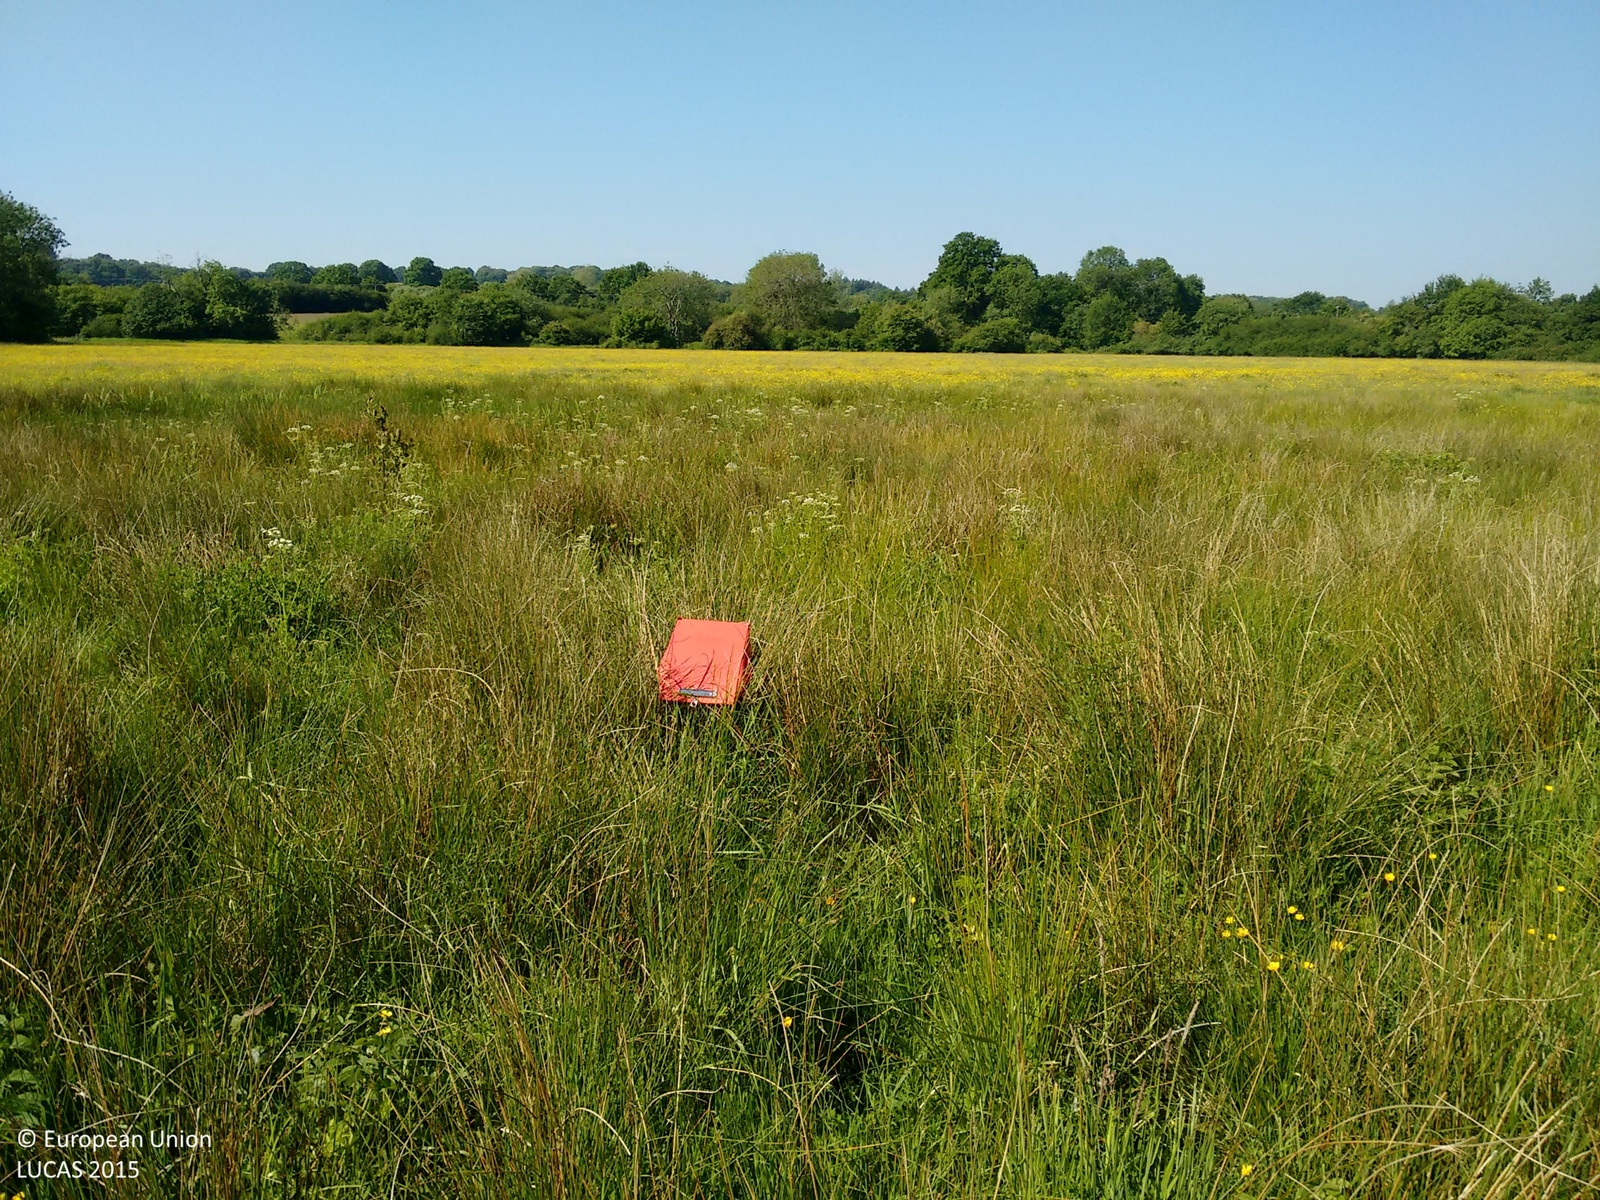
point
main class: Grassland
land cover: Grassland without tree/shrub cover
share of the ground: > 75 %
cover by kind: herbaceous plants 100 %
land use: Agriculture (excluding fallow land and kitchen gardens)
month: June
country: GB
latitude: 50.9973
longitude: 0.4679
